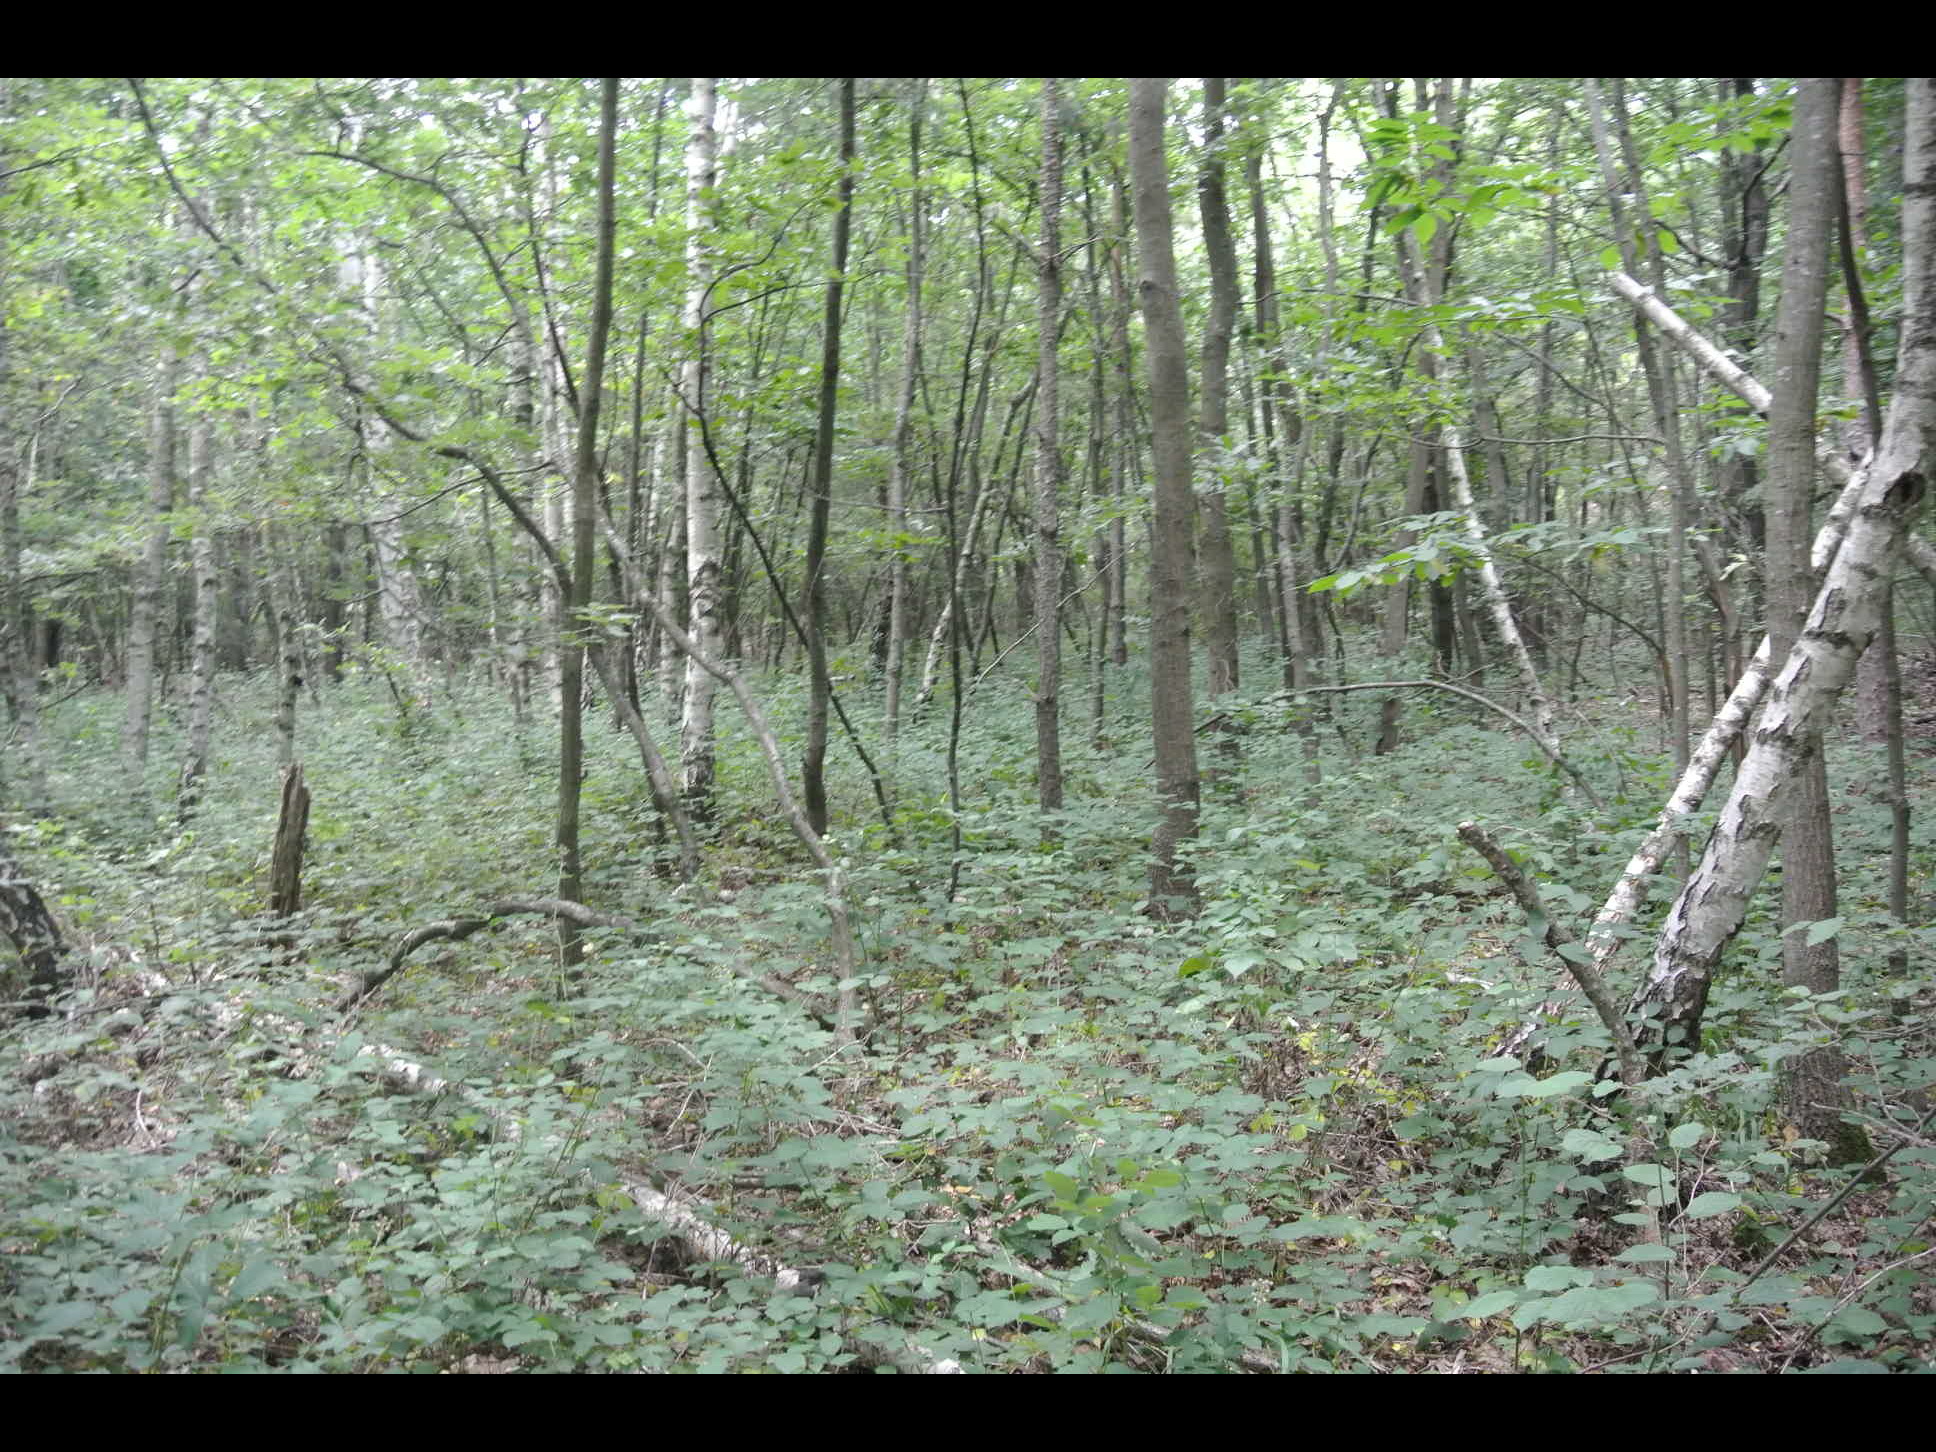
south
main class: Woodland
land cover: Broadleaved woodland
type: beech forest
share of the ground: > 75 %
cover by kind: broadleaved forest trees 100 %
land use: Forestry
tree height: > 5 m
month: July
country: AT
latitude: 47.7265
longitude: 16.4705
